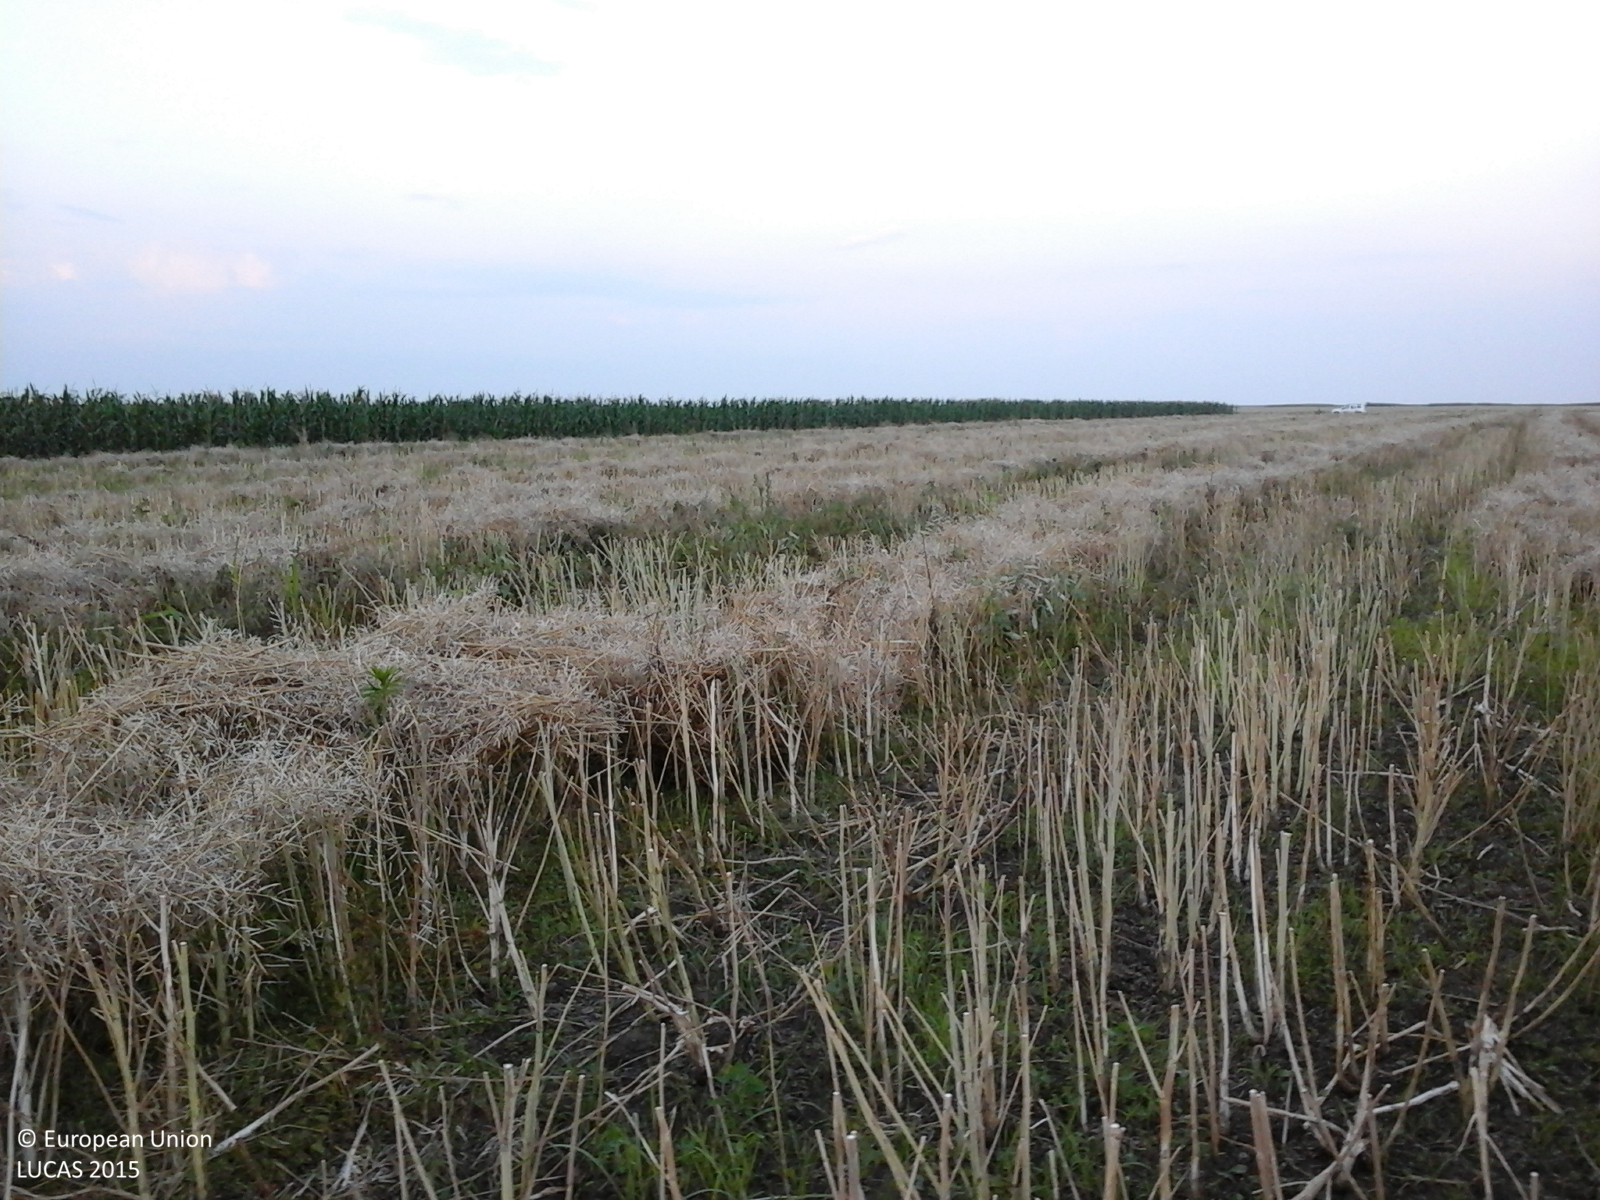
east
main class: Cropland
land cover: Rape and turnip rape
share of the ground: < 10 %
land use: Agriculture (excluding fallow land and kitchen gardens)
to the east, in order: Rape and turnip rape; Maize; Sunflower; Grass margins; Tracks; Grass margins; Durum wheat
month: July
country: RO
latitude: 43.7659
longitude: 25.2464
